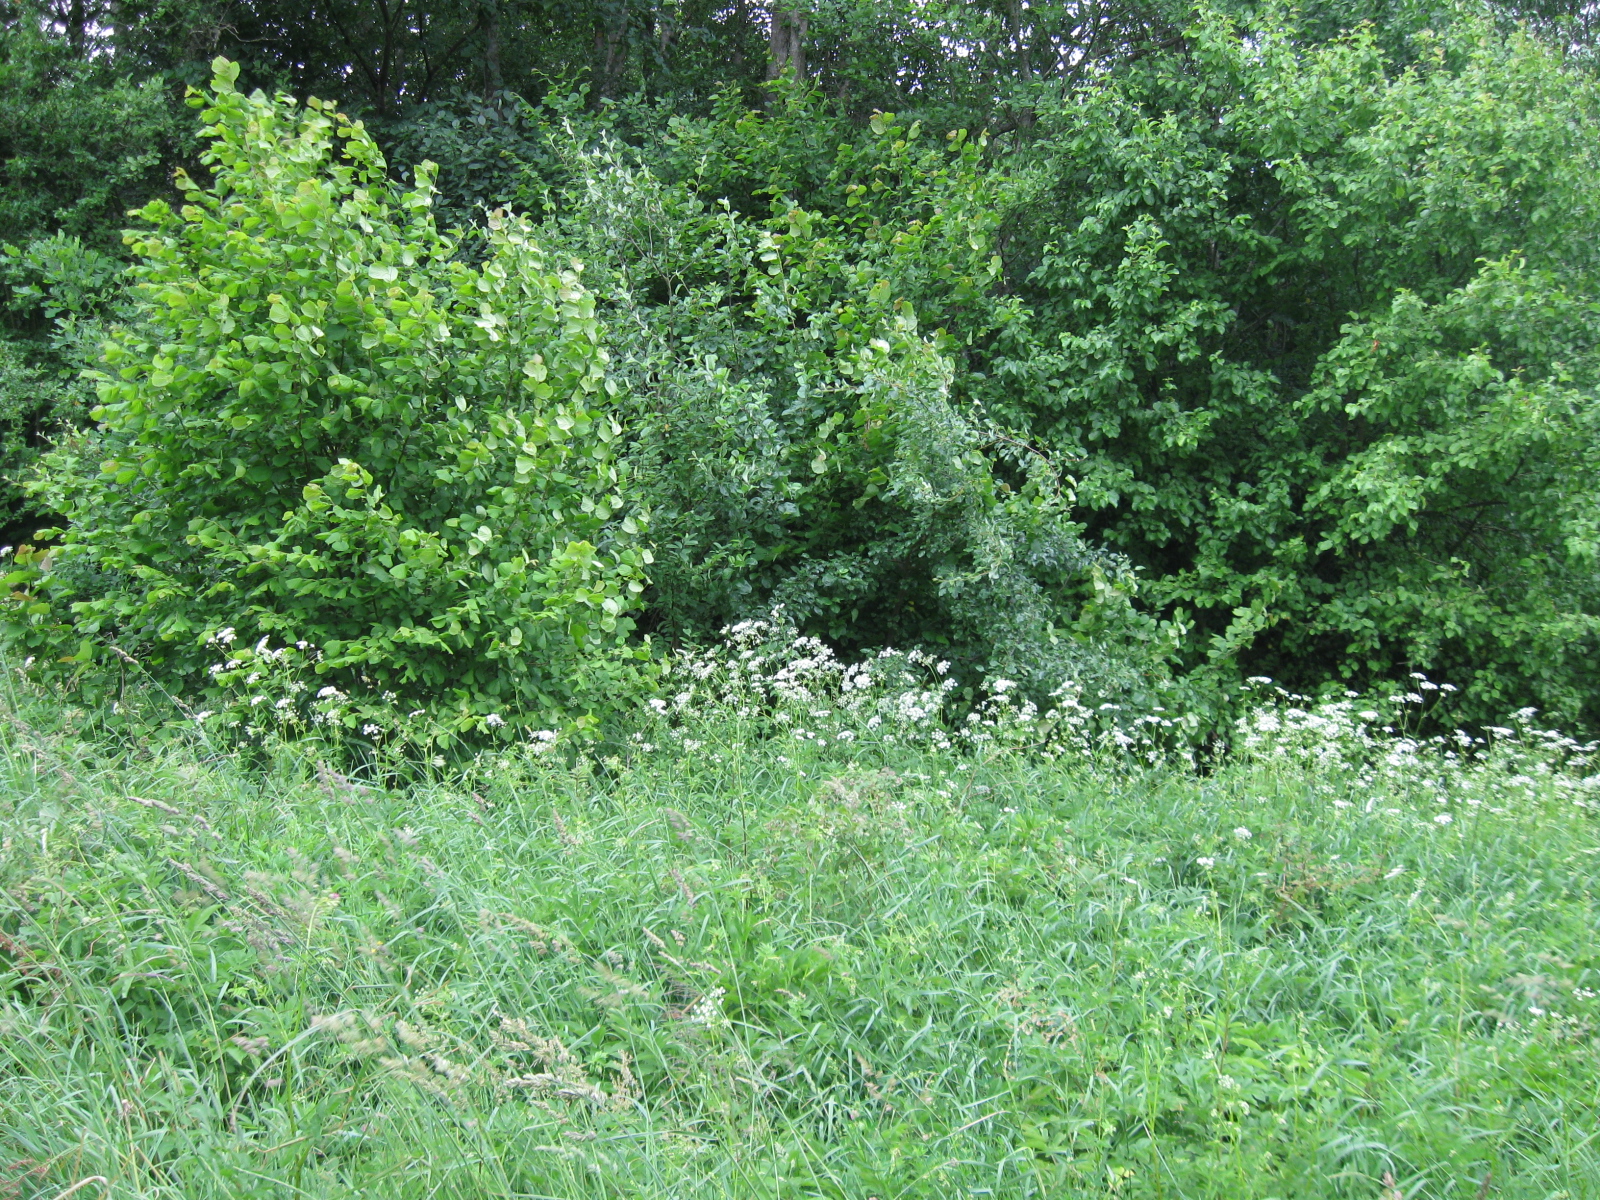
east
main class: Grassland
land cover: Grassland with sparse tree/shrub cover
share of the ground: > 75 %
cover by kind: herbaceous plants 90 %, broadleaved forest trees 5 %, shrubs 5 %
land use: Agriculture (excluding fallow land and kitchen gardens)
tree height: < 5 m
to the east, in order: Grassland with sparse tree/shrub cover; Broadleaved woodland; Spontaneously vegetated surfaces; Electric lines; Spontaneously vegetated surfaces; Broadleaved woodland
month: June
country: LT
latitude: 54.6236
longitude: 24.3643
